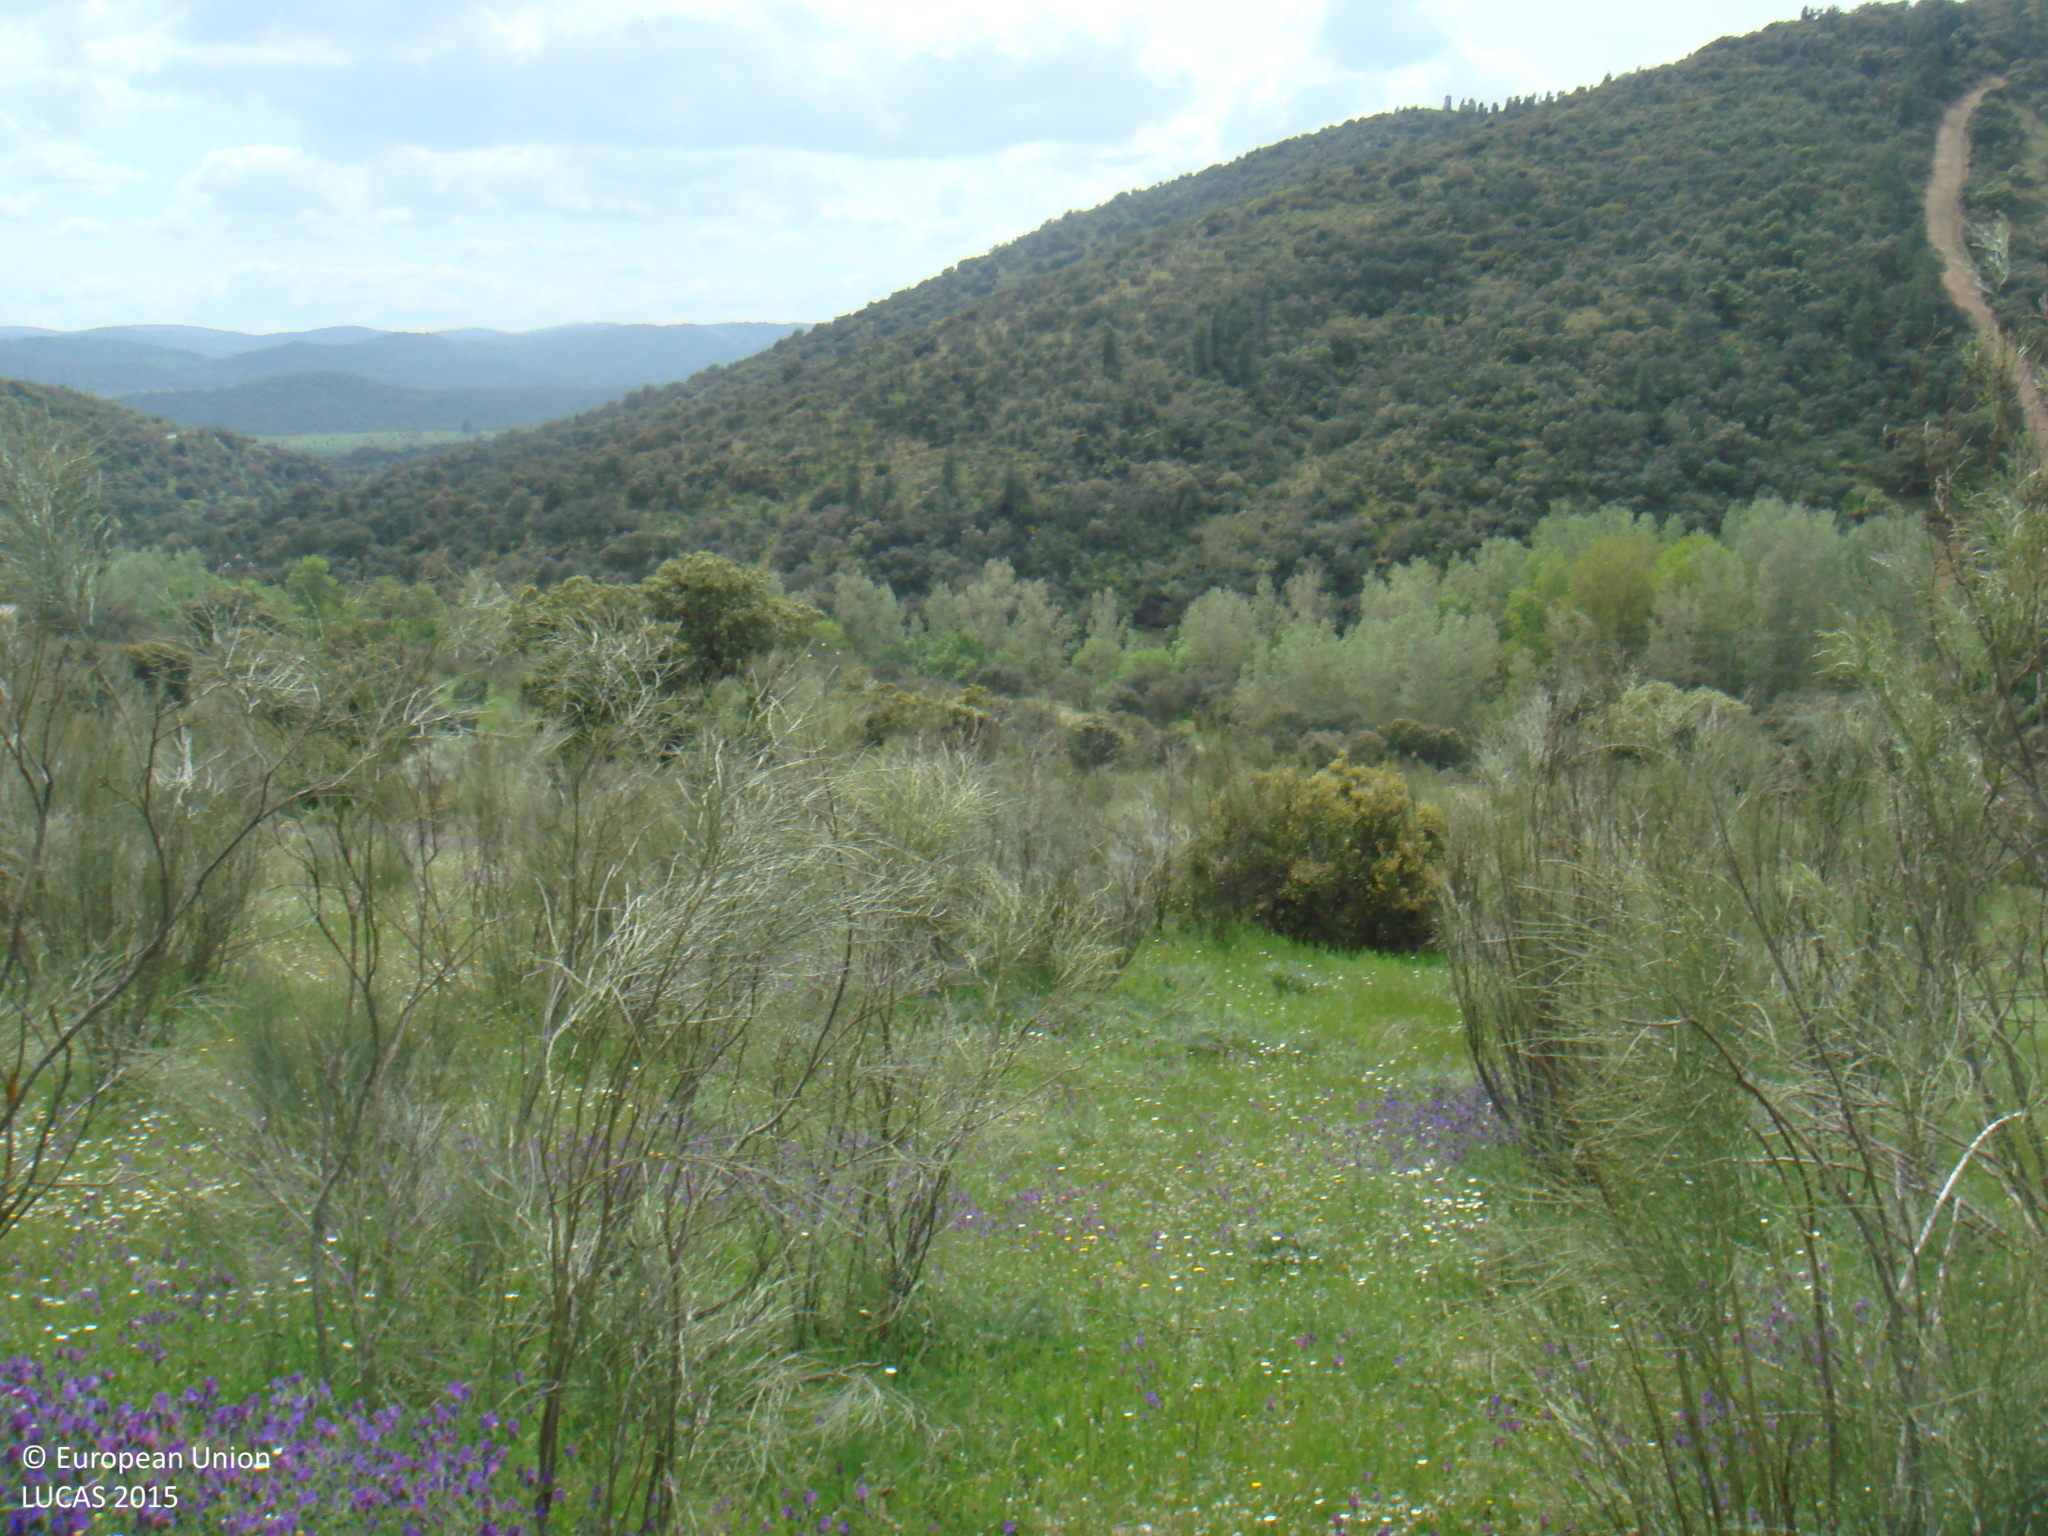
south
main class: Shrubland
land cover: Shrubland with sparse tree cover
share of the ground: 25 - 50 %
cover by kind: herbaceous plants 55 %, shrubs 40 %, broadleaved forest trees 5 %
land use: Semi-natural and natural areas not in use
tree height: > 5 m
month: April
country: ES
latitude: 38.2178
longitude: -5.0434
